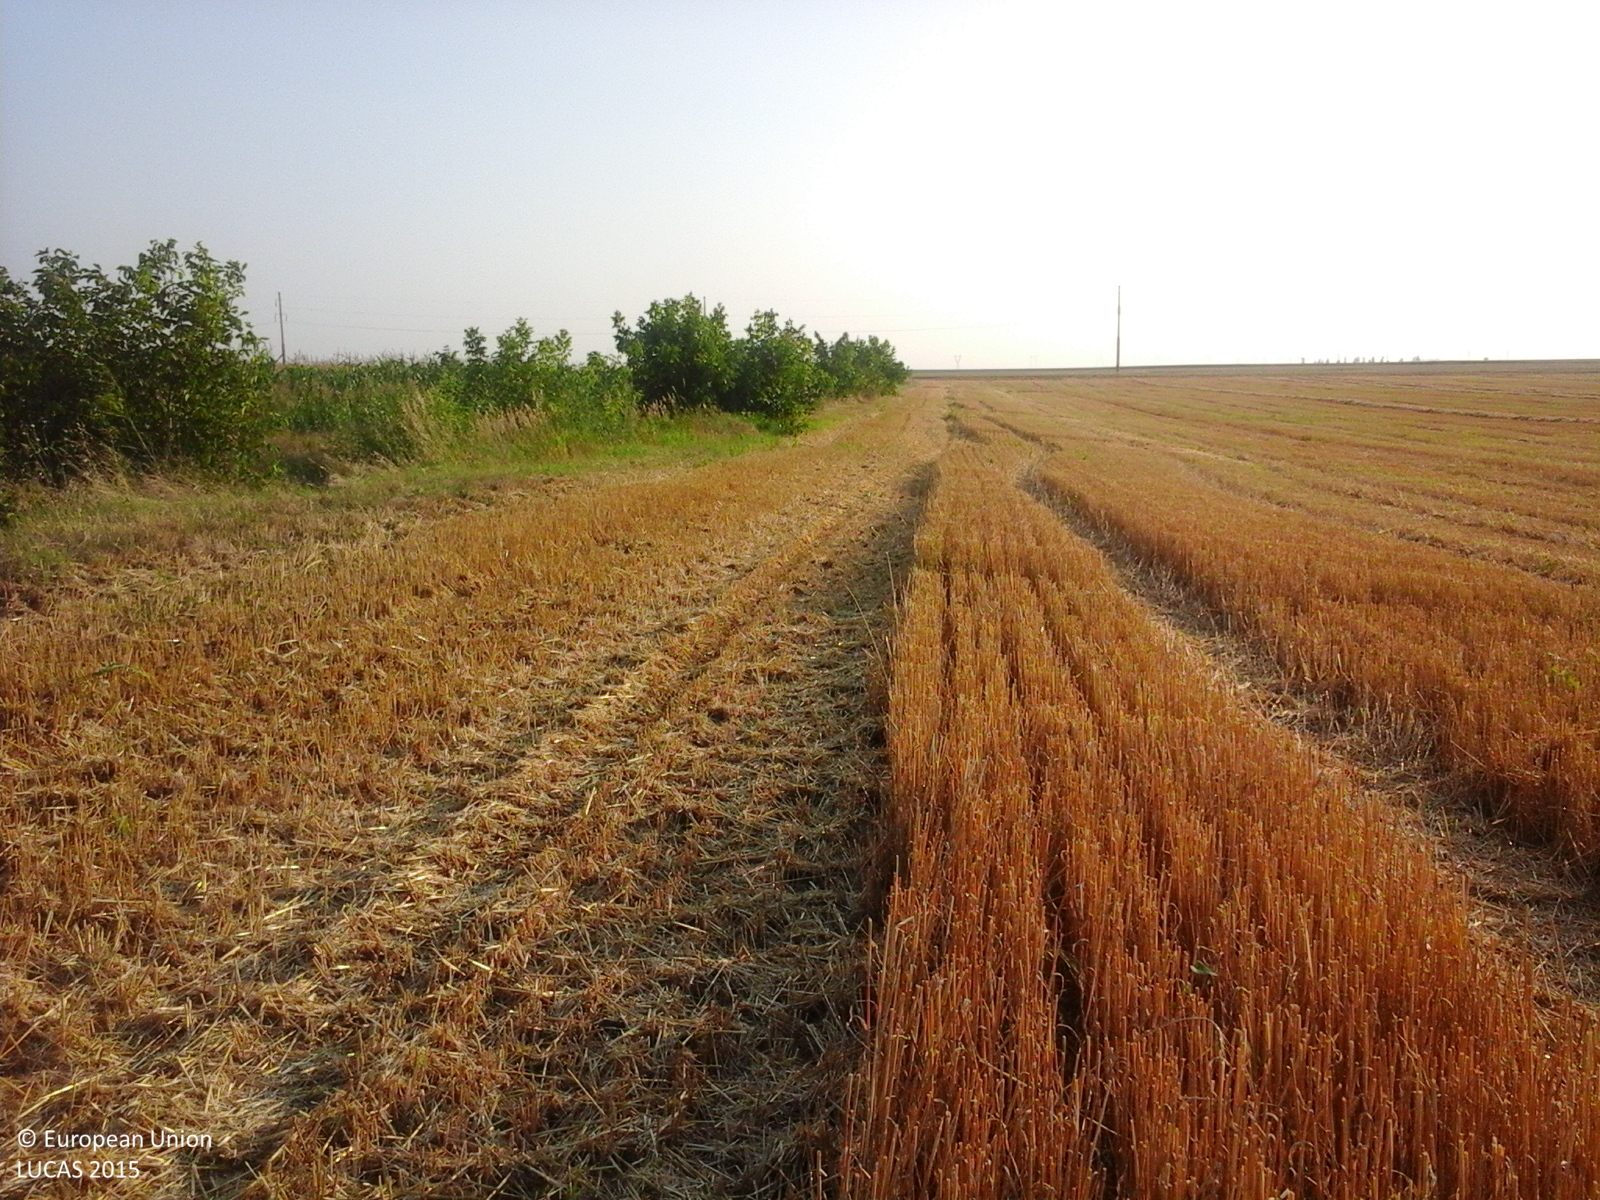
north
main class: Cropland
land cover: Durum wheat
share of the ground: 25 - 50 %
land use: Agriculture (excluding fallow land and kitchen gardens)
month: July
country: RO
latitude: 44.5888
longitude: 27.1254
